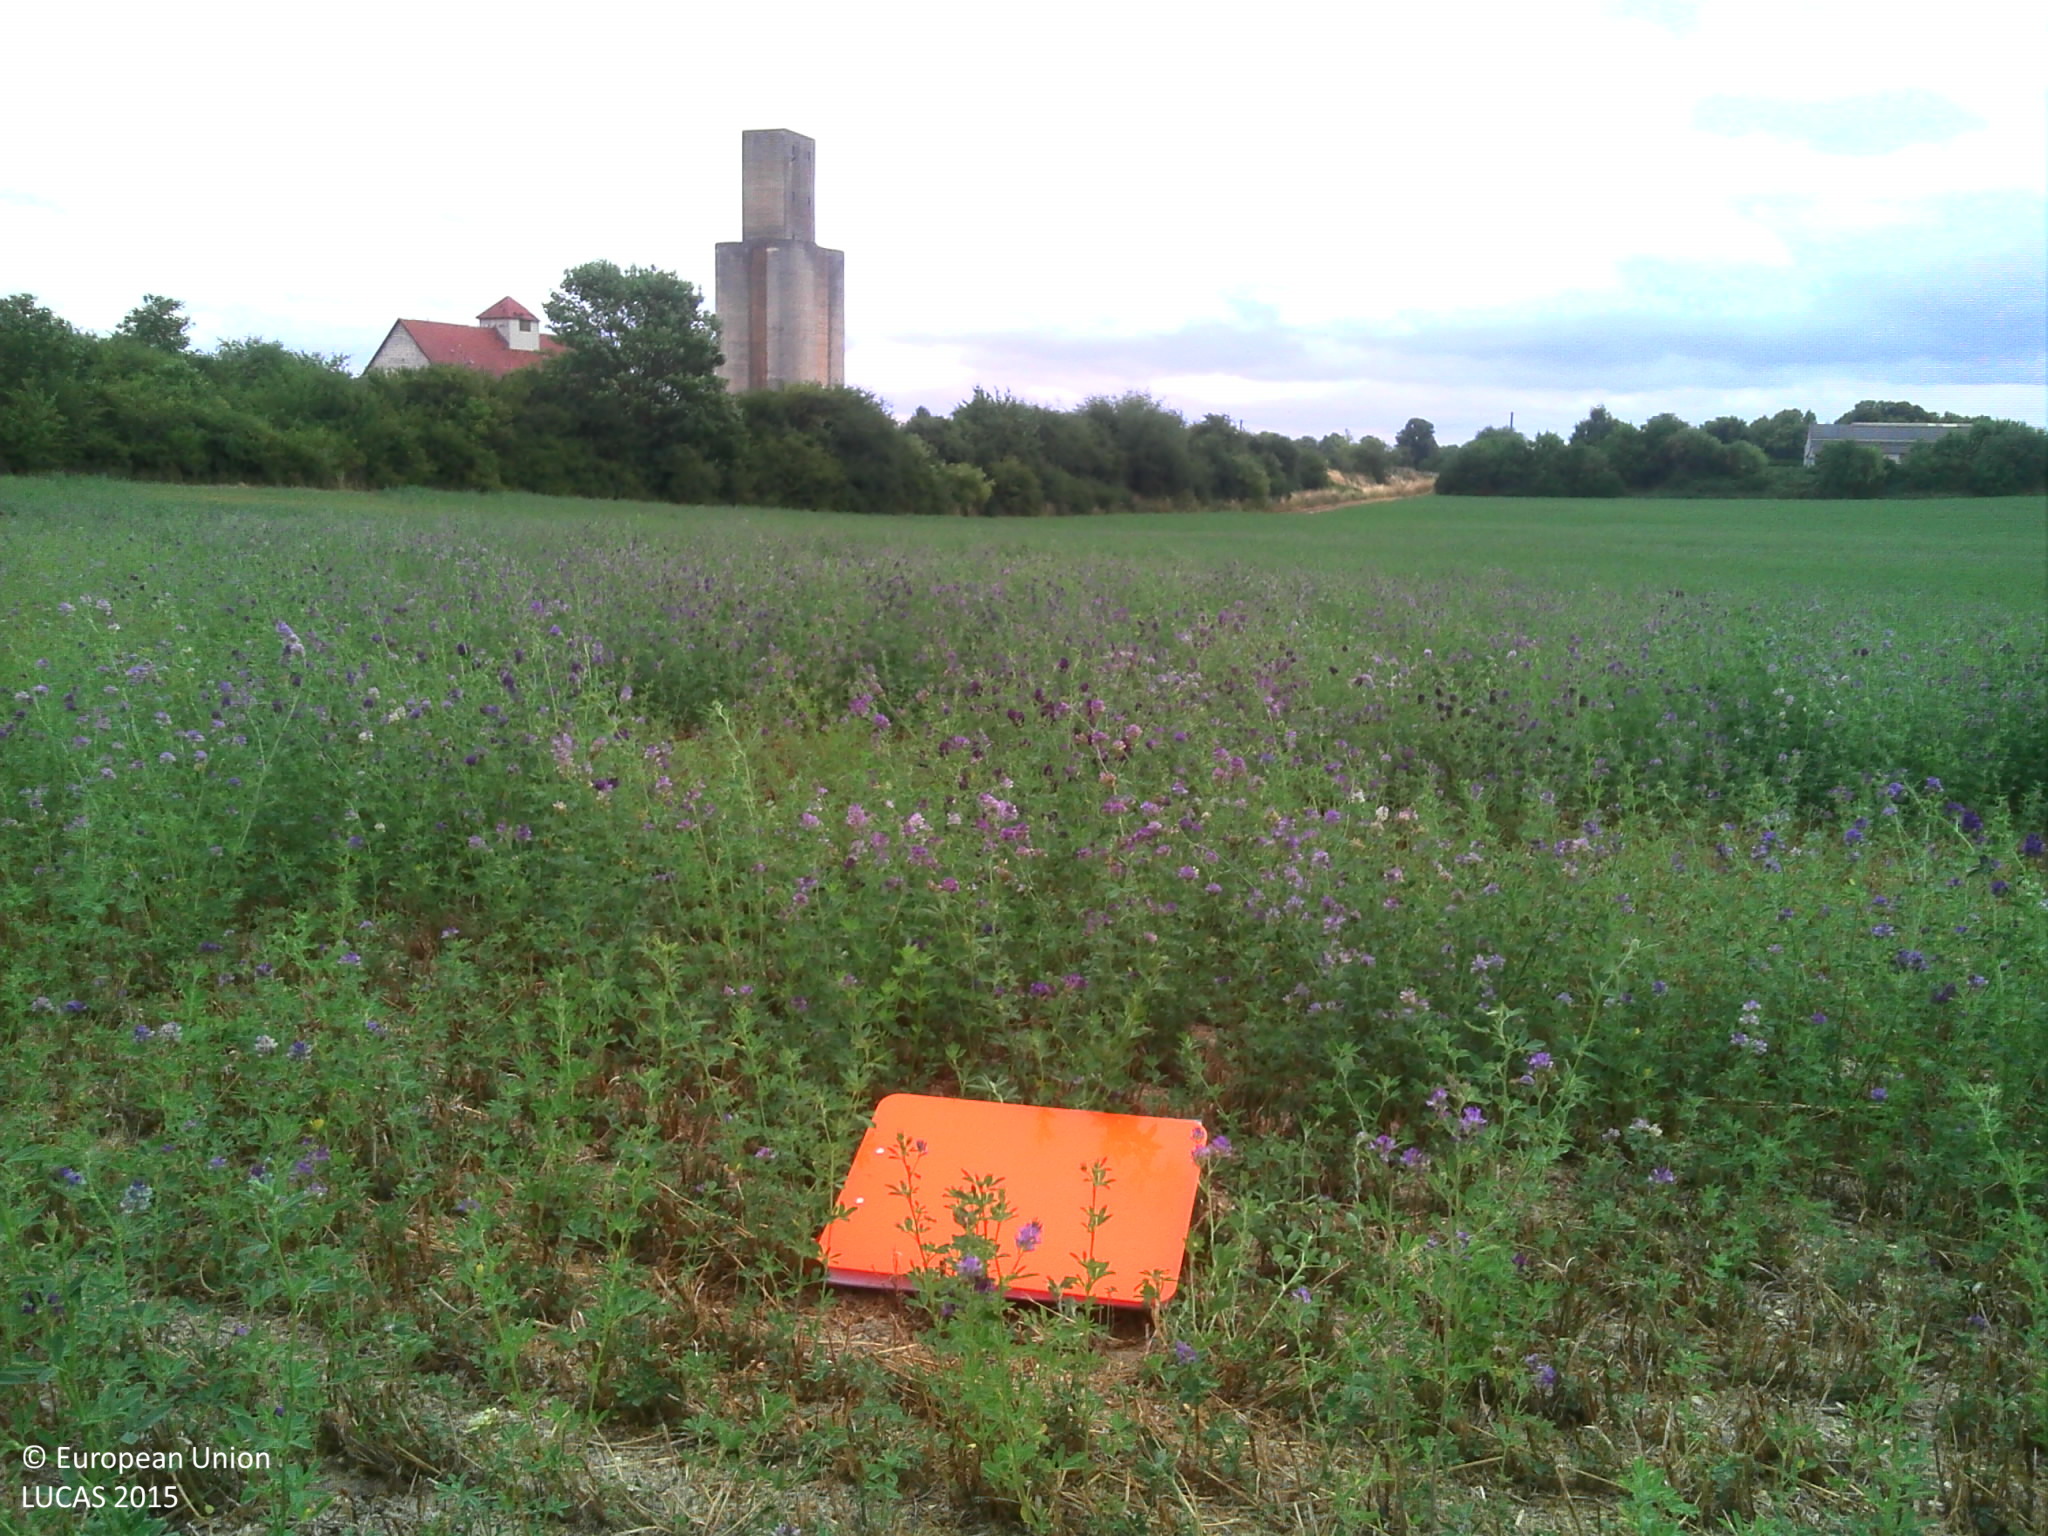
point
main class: Cropland
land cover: Lucerne
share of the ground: > 75 %
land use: Agriculture (excluding fallow land and kitchen gardens)
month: July
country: FR
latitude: 48.7378
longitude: 4.1899
